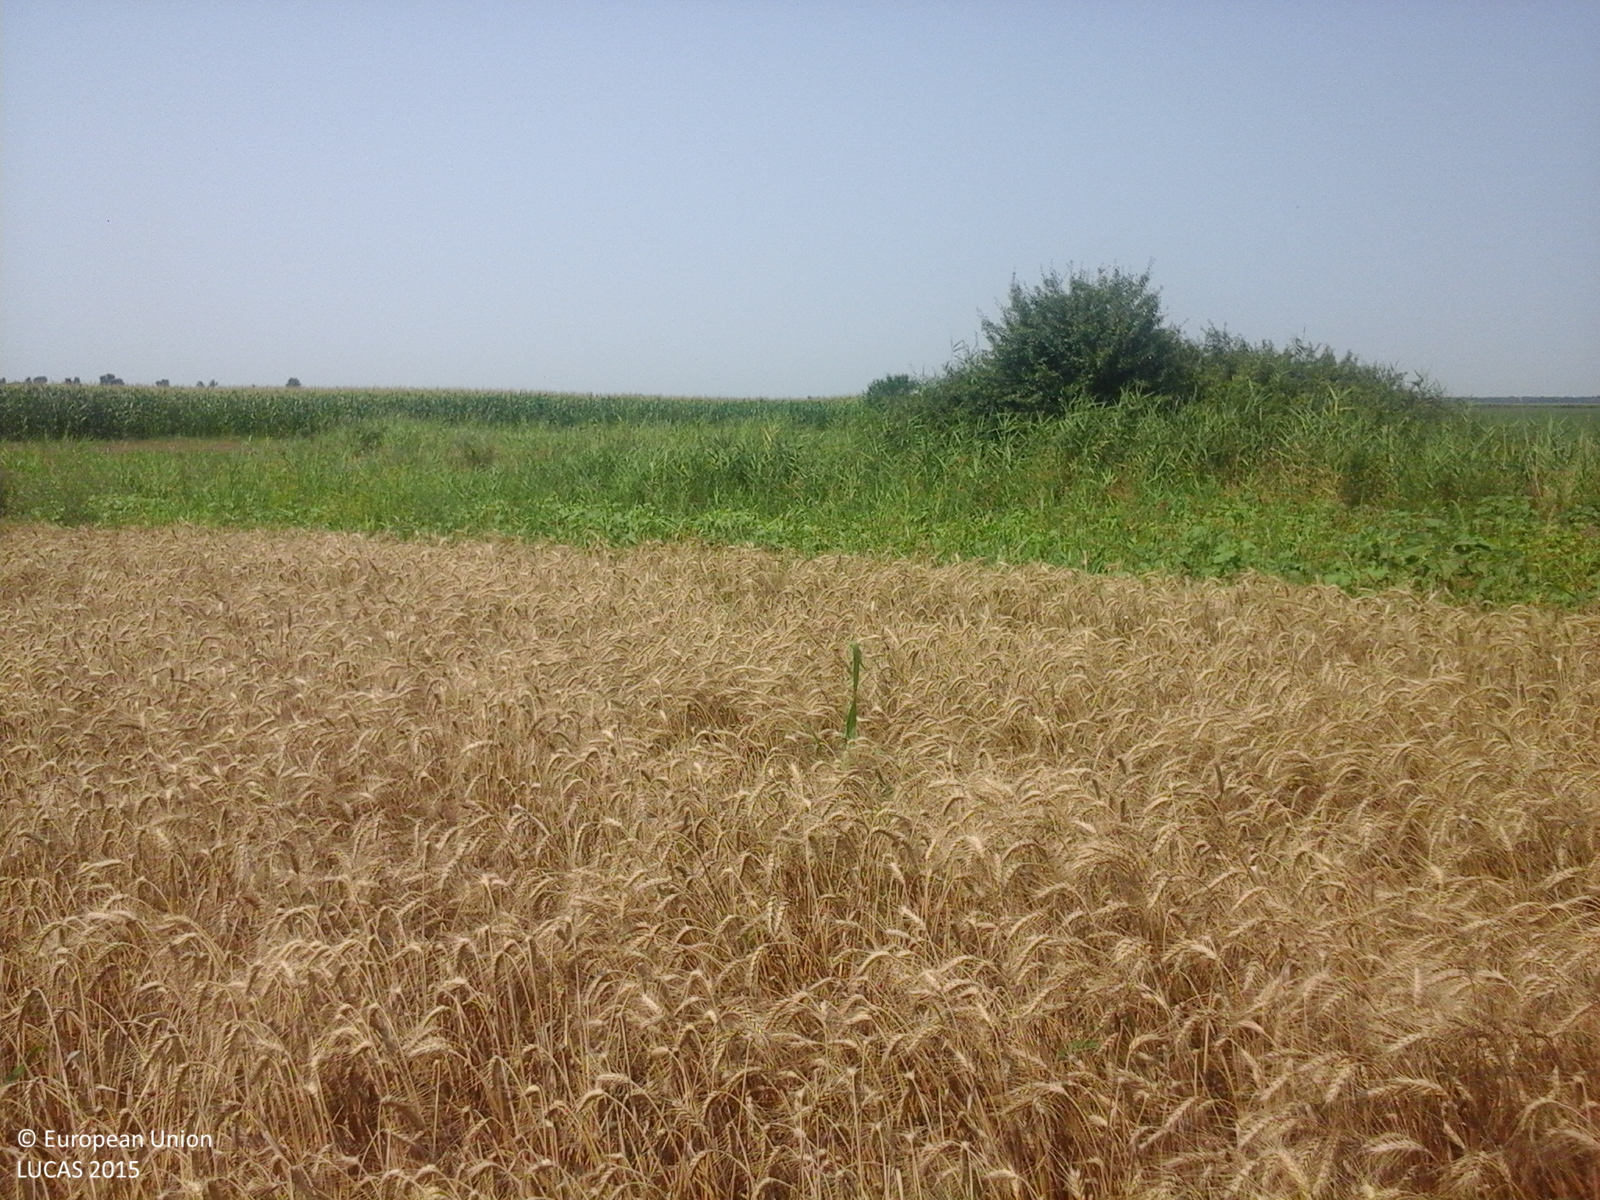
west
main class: Cropland
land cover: Durum wheat
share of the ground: > 75 %
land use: Agriculture (excluding fallow land and kitchen gardens)
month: July
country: RO
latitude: 44.7207
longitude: 26.5438
